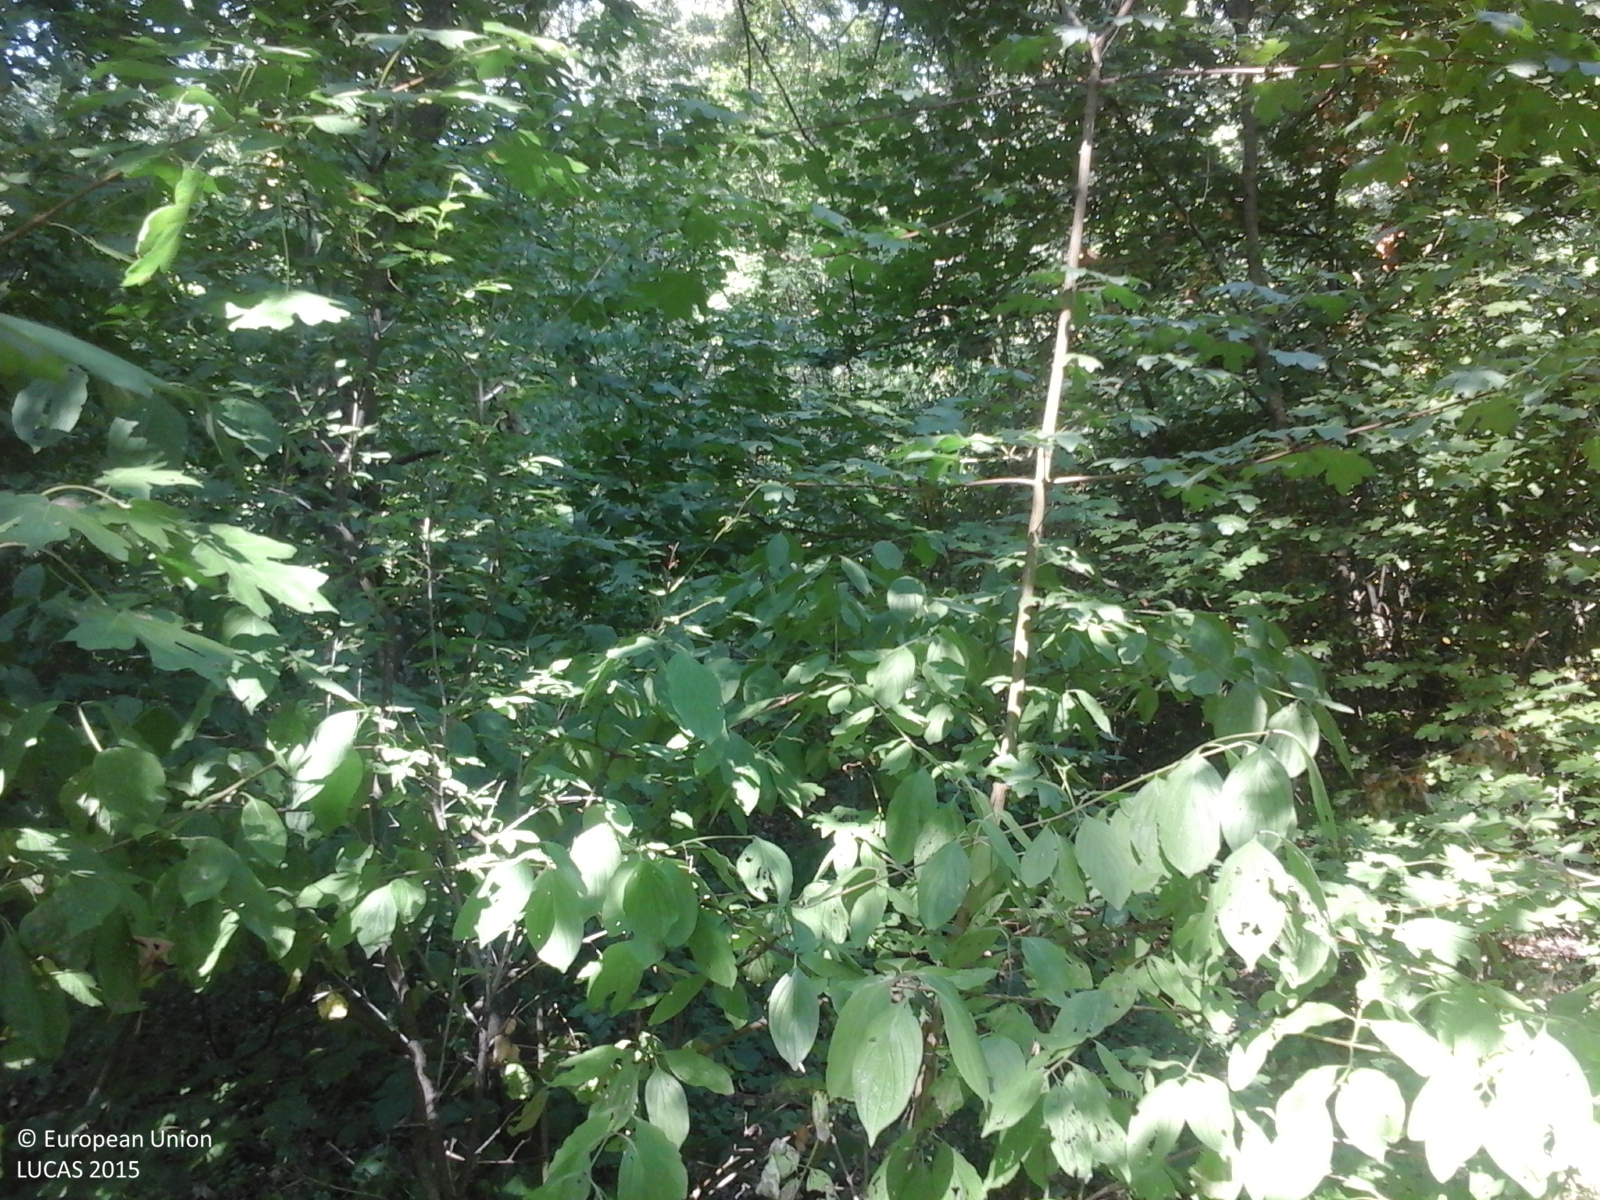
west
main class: Woodland
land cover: Broadleaved woodland
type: acidophilous oak and oak-birch forest
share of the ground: > 75 %
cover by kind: broadleaved forest trees 100 %
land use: Forestry
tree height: > 5 m
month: August
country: RO
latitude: 45.6896
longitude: 27.4770
